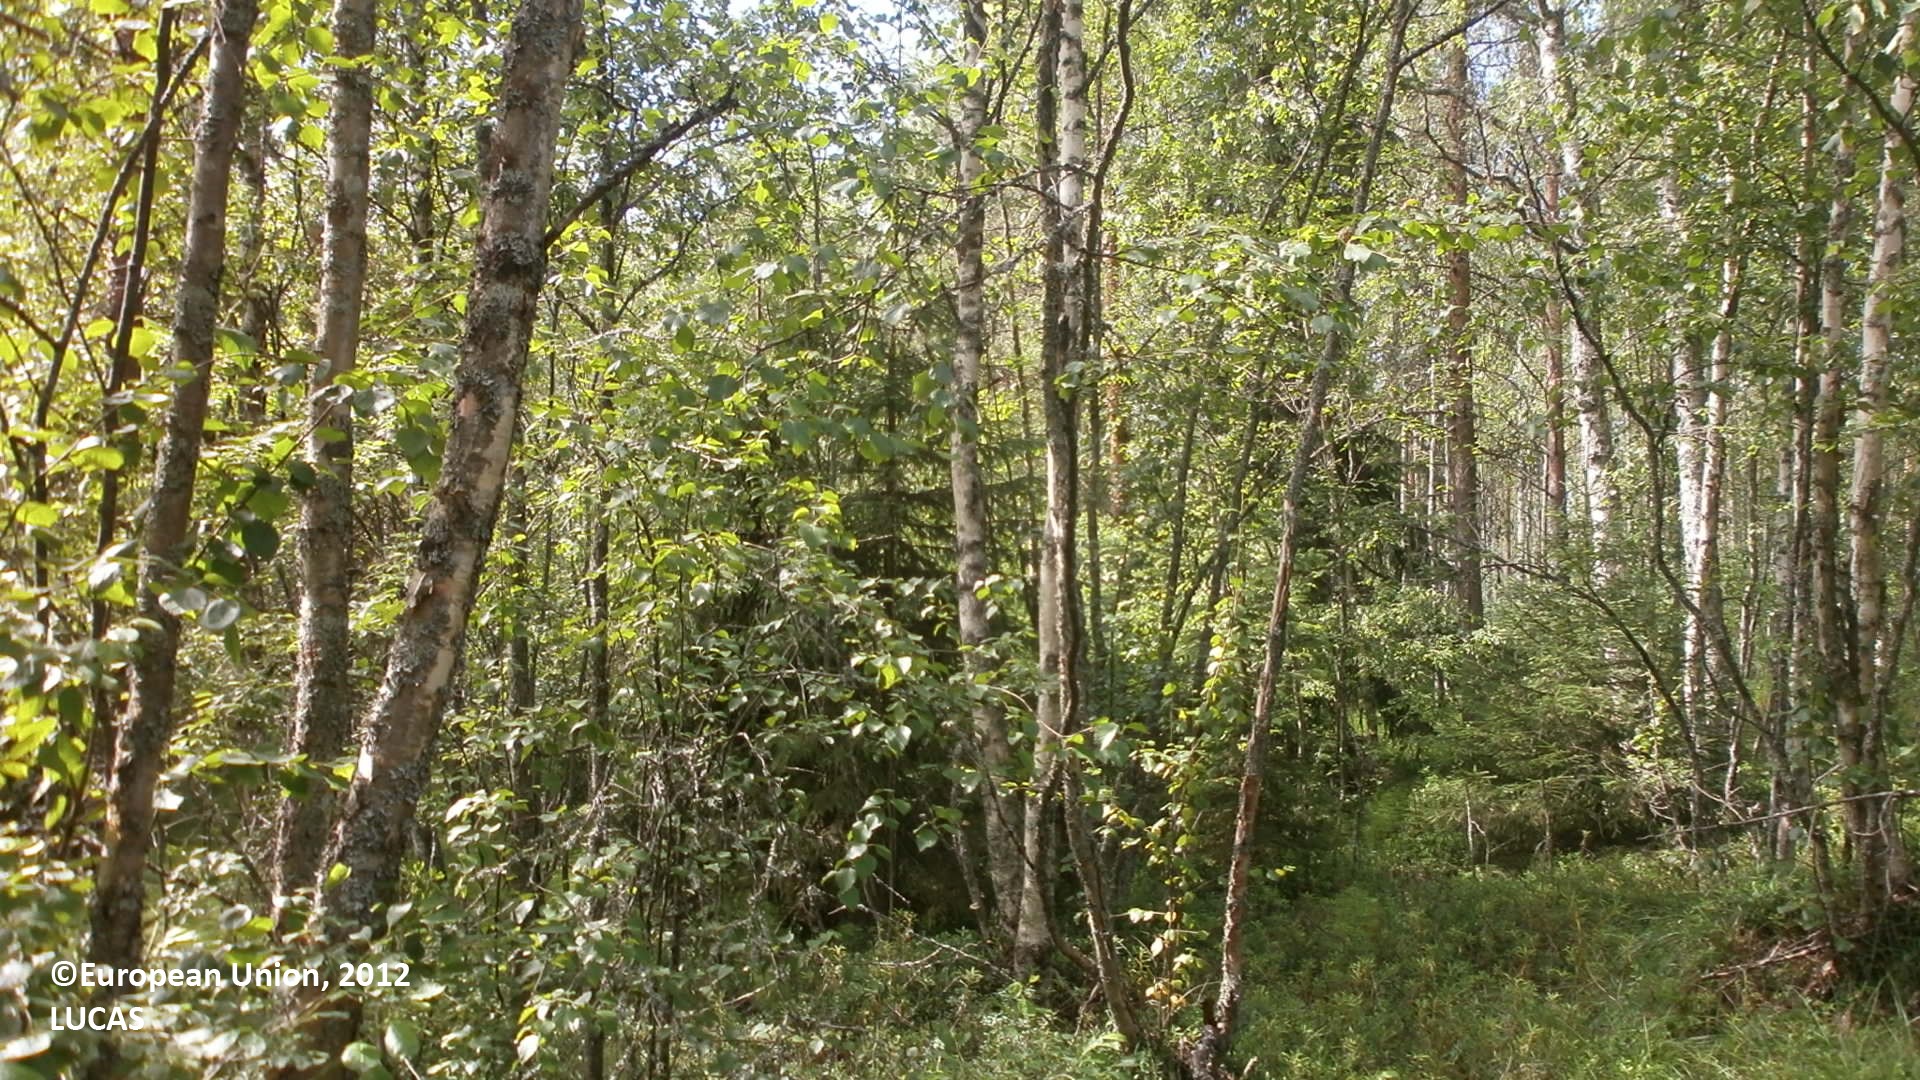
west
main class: Woodland
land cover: Pine dominated mixed woodland
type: boreal forest
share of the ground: 50 - 75 %
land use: Forestry
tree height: > 5 m
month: July
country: FI
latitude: 64.2349
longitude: 24.1904
